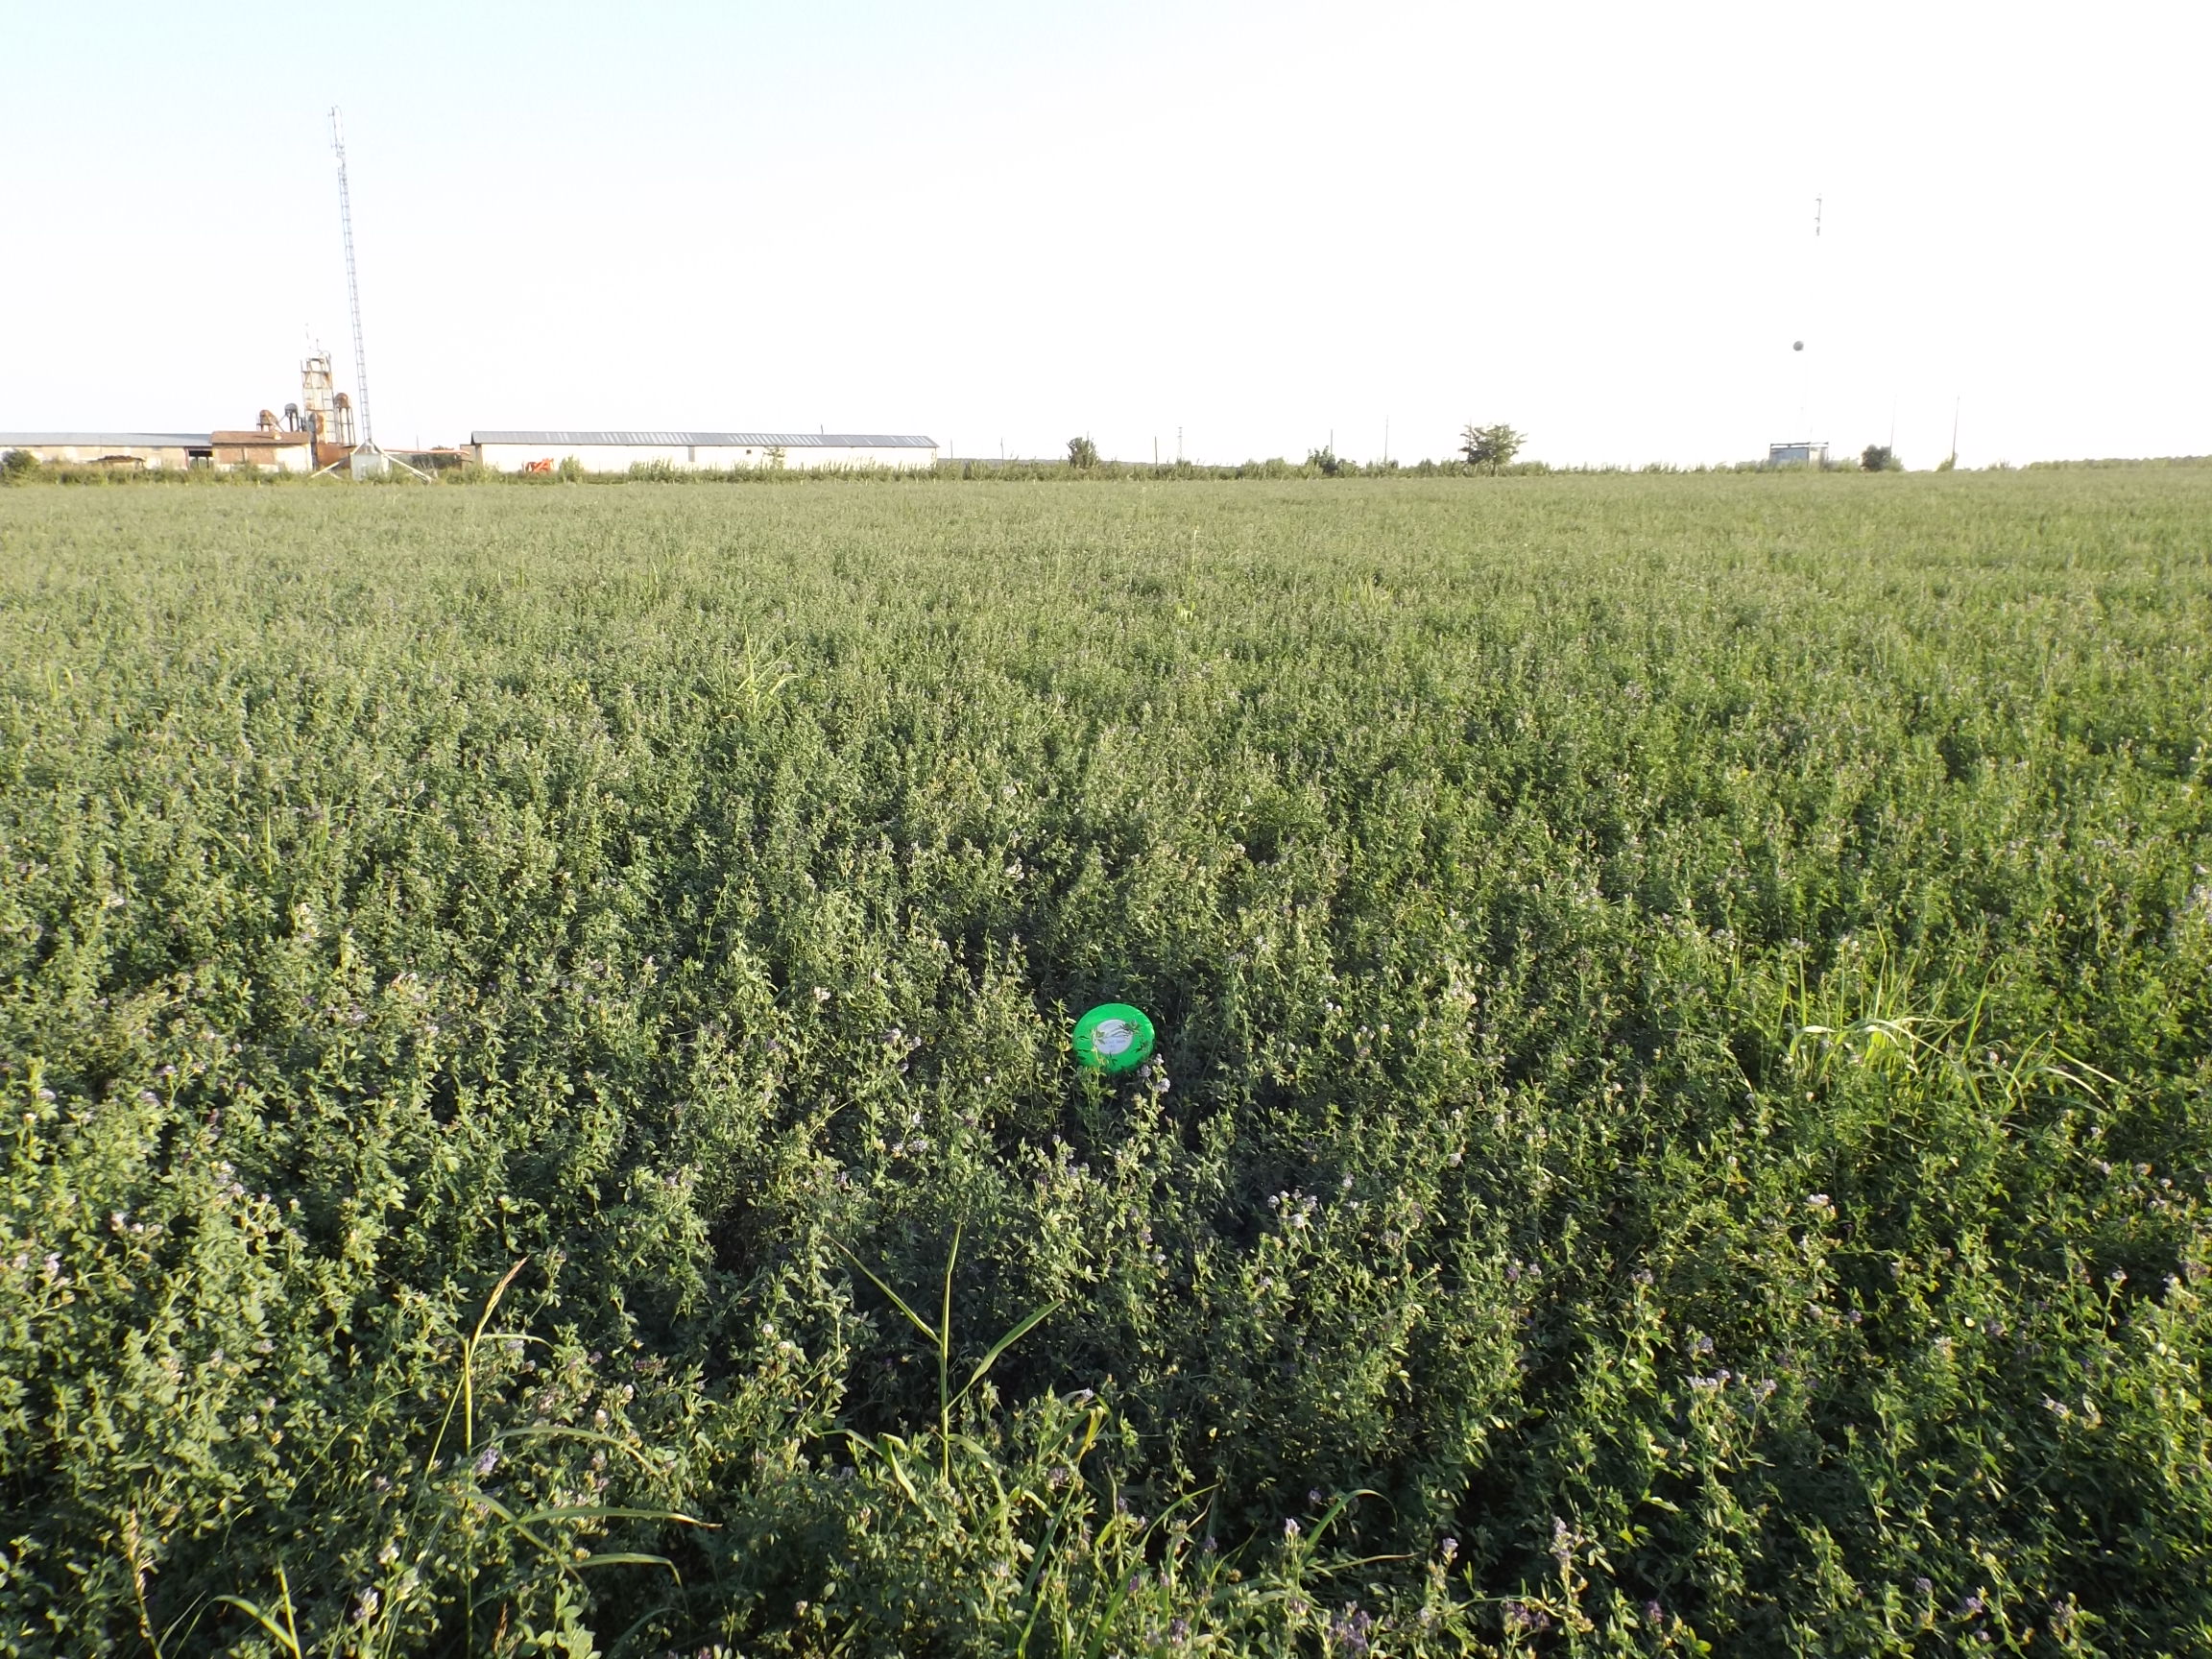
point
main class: Cropland
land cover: Lucerne
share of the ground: > 75 %
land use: Agriculture (excluding fallow land and kitchen gardens)
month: September
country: BG
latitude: 43.9948
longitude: 26.7130
